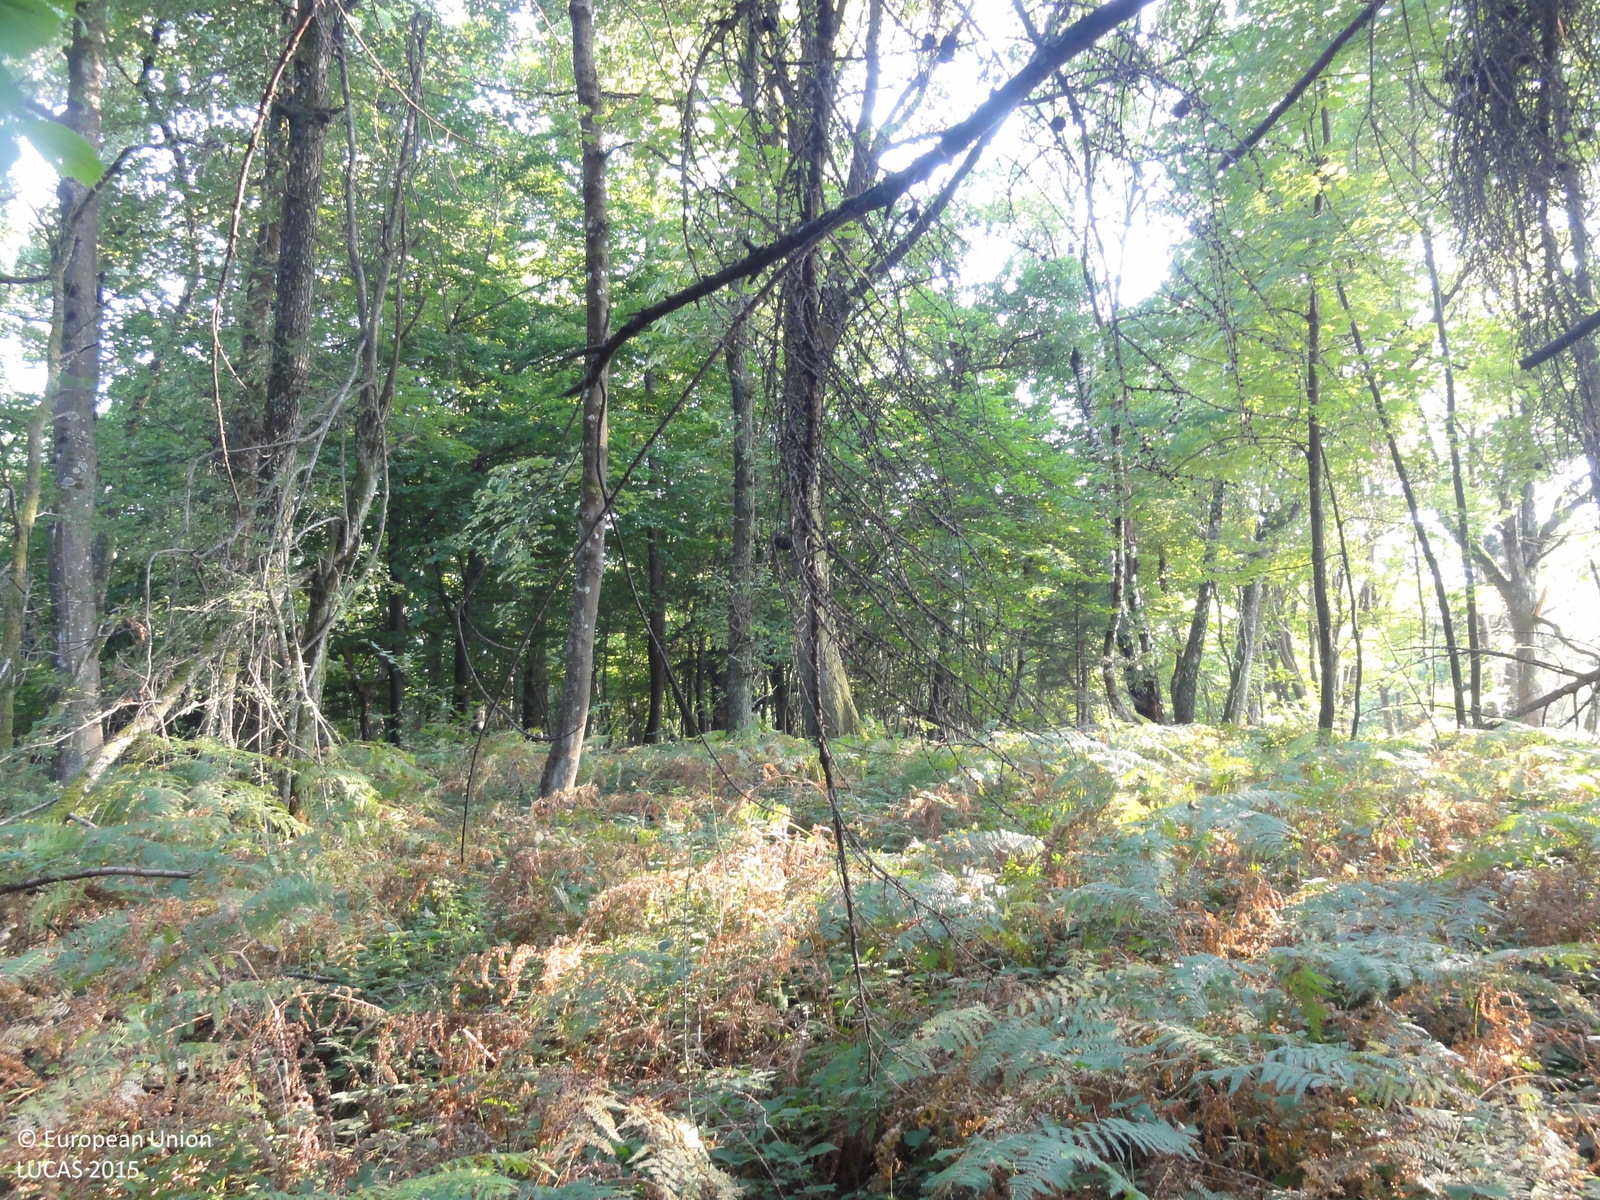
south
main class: Woodland
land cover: Spruce dominated mixed woodland
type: mesophytic deciduous forest
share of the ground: > 75 %
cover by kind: broadleaved forest trees 60 %, coniferous forest trees 40 %
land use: Forestry
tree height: > 5 m
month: August
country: SI
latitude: 45.8179
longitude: 15.0287
